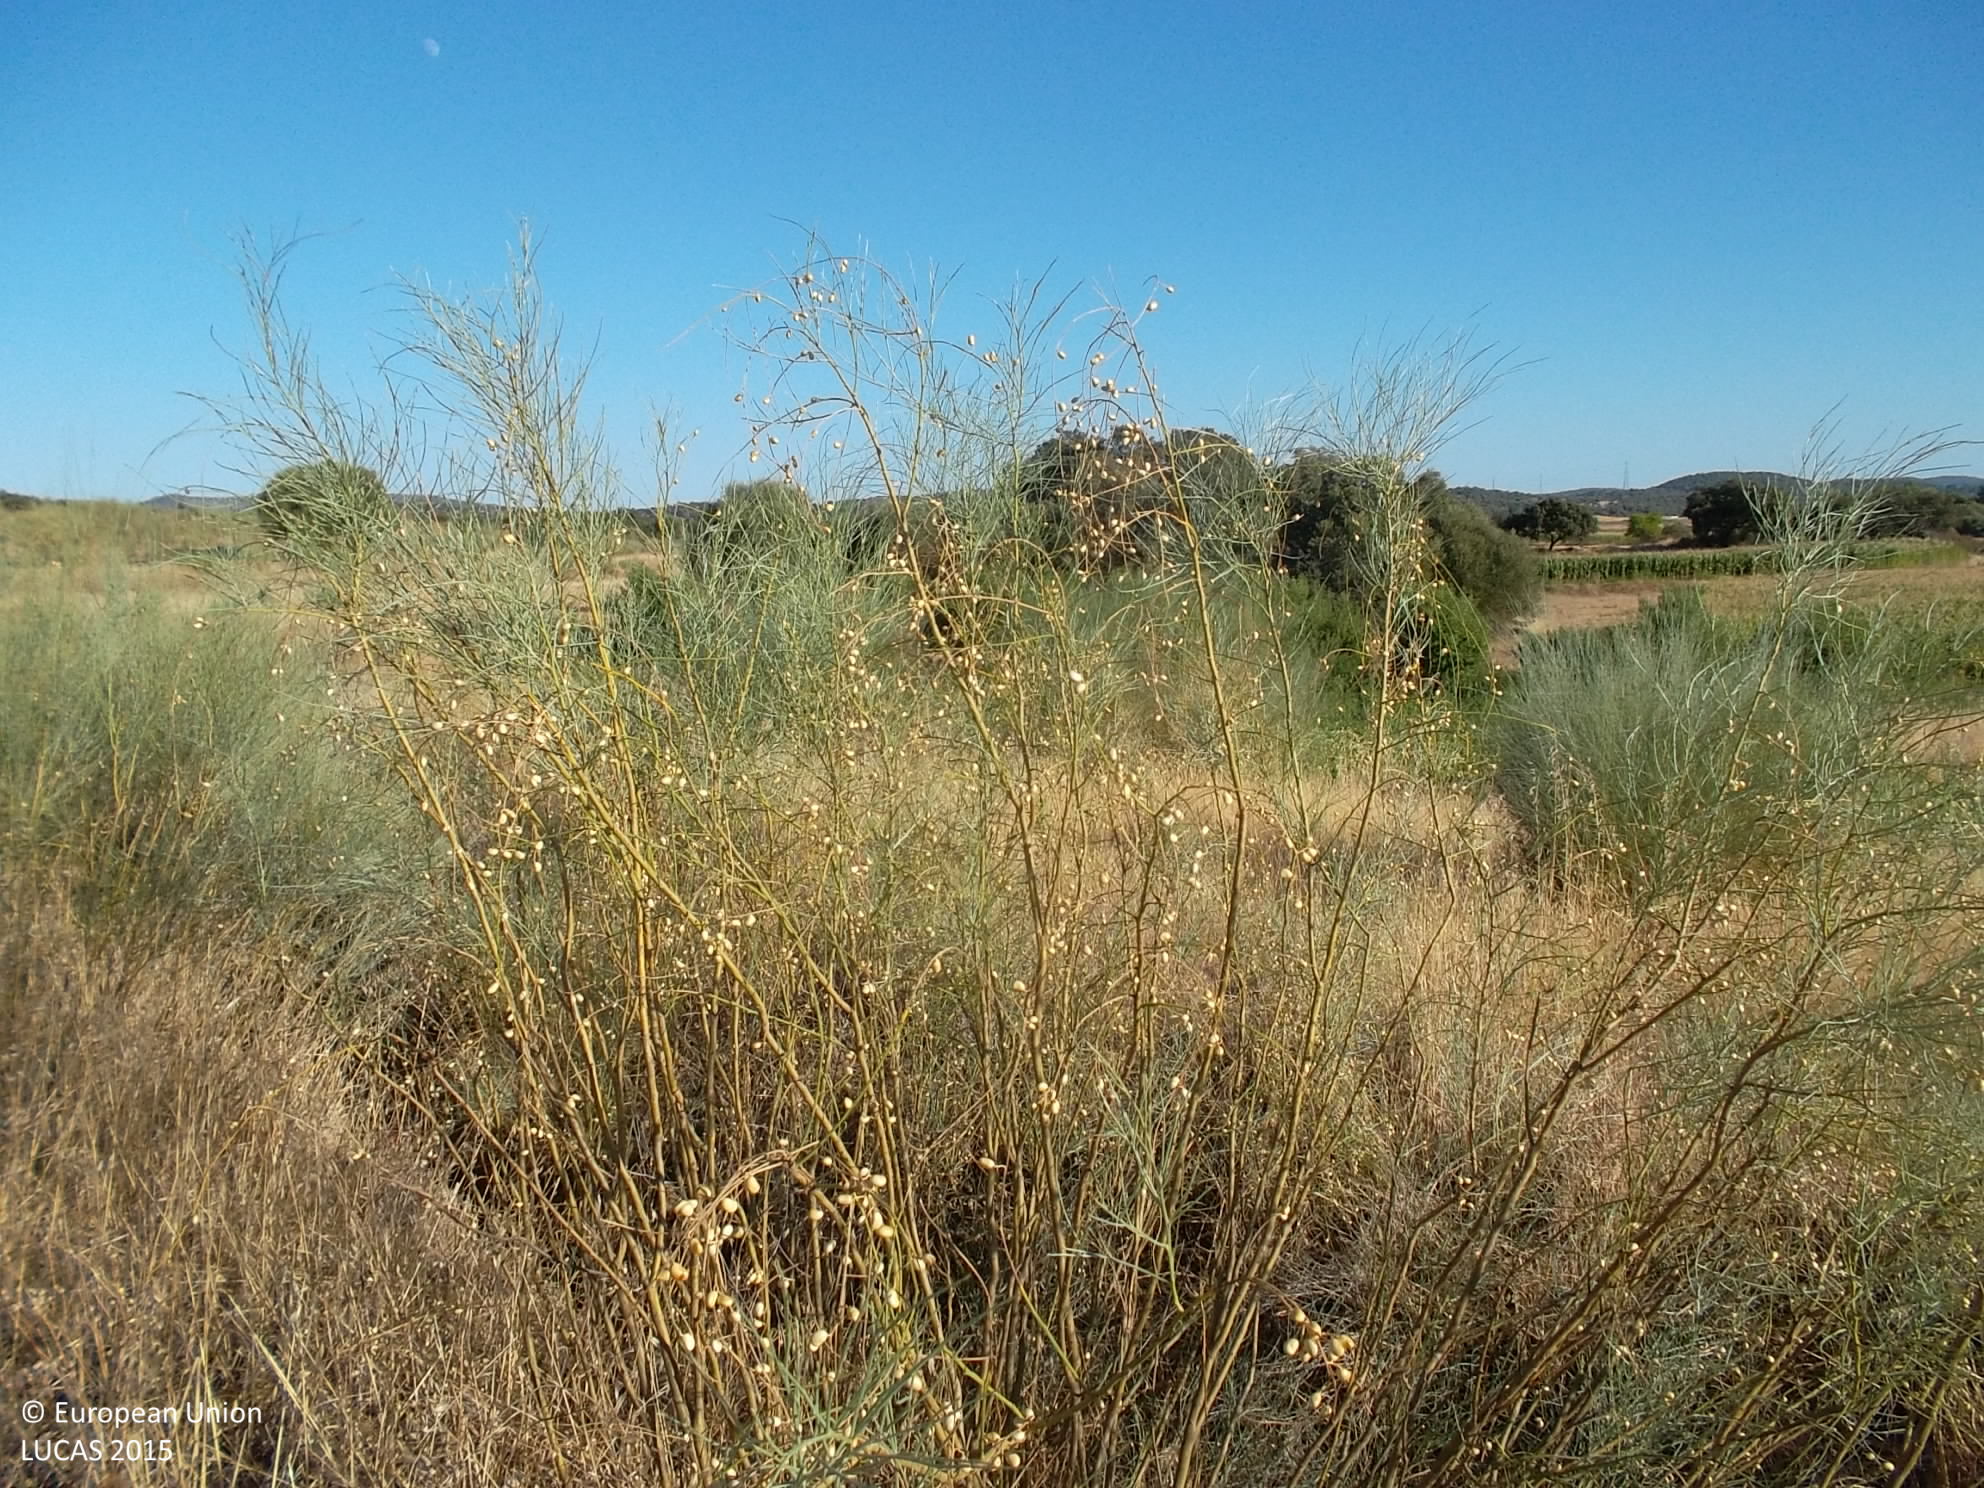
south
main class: Shrubland
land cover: Shrubland with sparse tree cover
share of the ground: > 75 %
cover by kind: herbaceous plants 75 %, shrubs 20 %, broadleaved forest trees 5 %
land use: Agriculture (excluding fallow land and kitchen gardens)
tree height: < 5 m
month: August
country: ES
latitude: 38.3663
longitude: -6.6844
